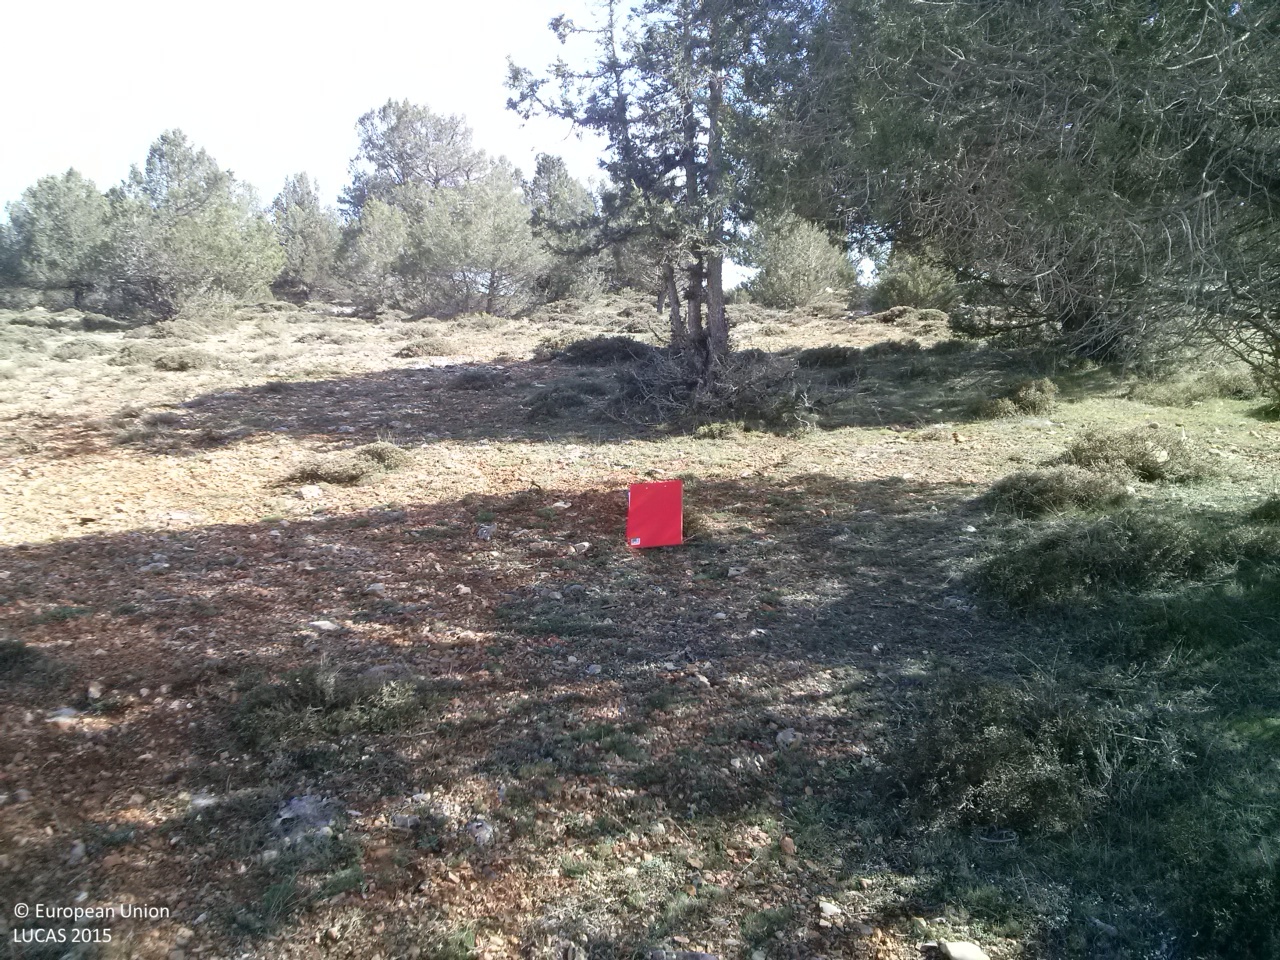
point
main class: Woodland
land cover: Other coniferous woodland
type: coniferous forest of the mediterranean region
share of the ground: 10 - 25 %
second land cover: Grassland without tree/shrub cover
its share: 25 - 50 %
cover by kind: unconsolidated bare surface 50 %, herbaceous plants 30 %, coniferous forest trees 15 %, shrubs 5 %
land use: Forestry
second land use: Agriculture (excluding fallow land and kitchen gardens)
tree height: < 5 m
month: April
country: ES
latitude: 40.0963
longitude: -1.6833
